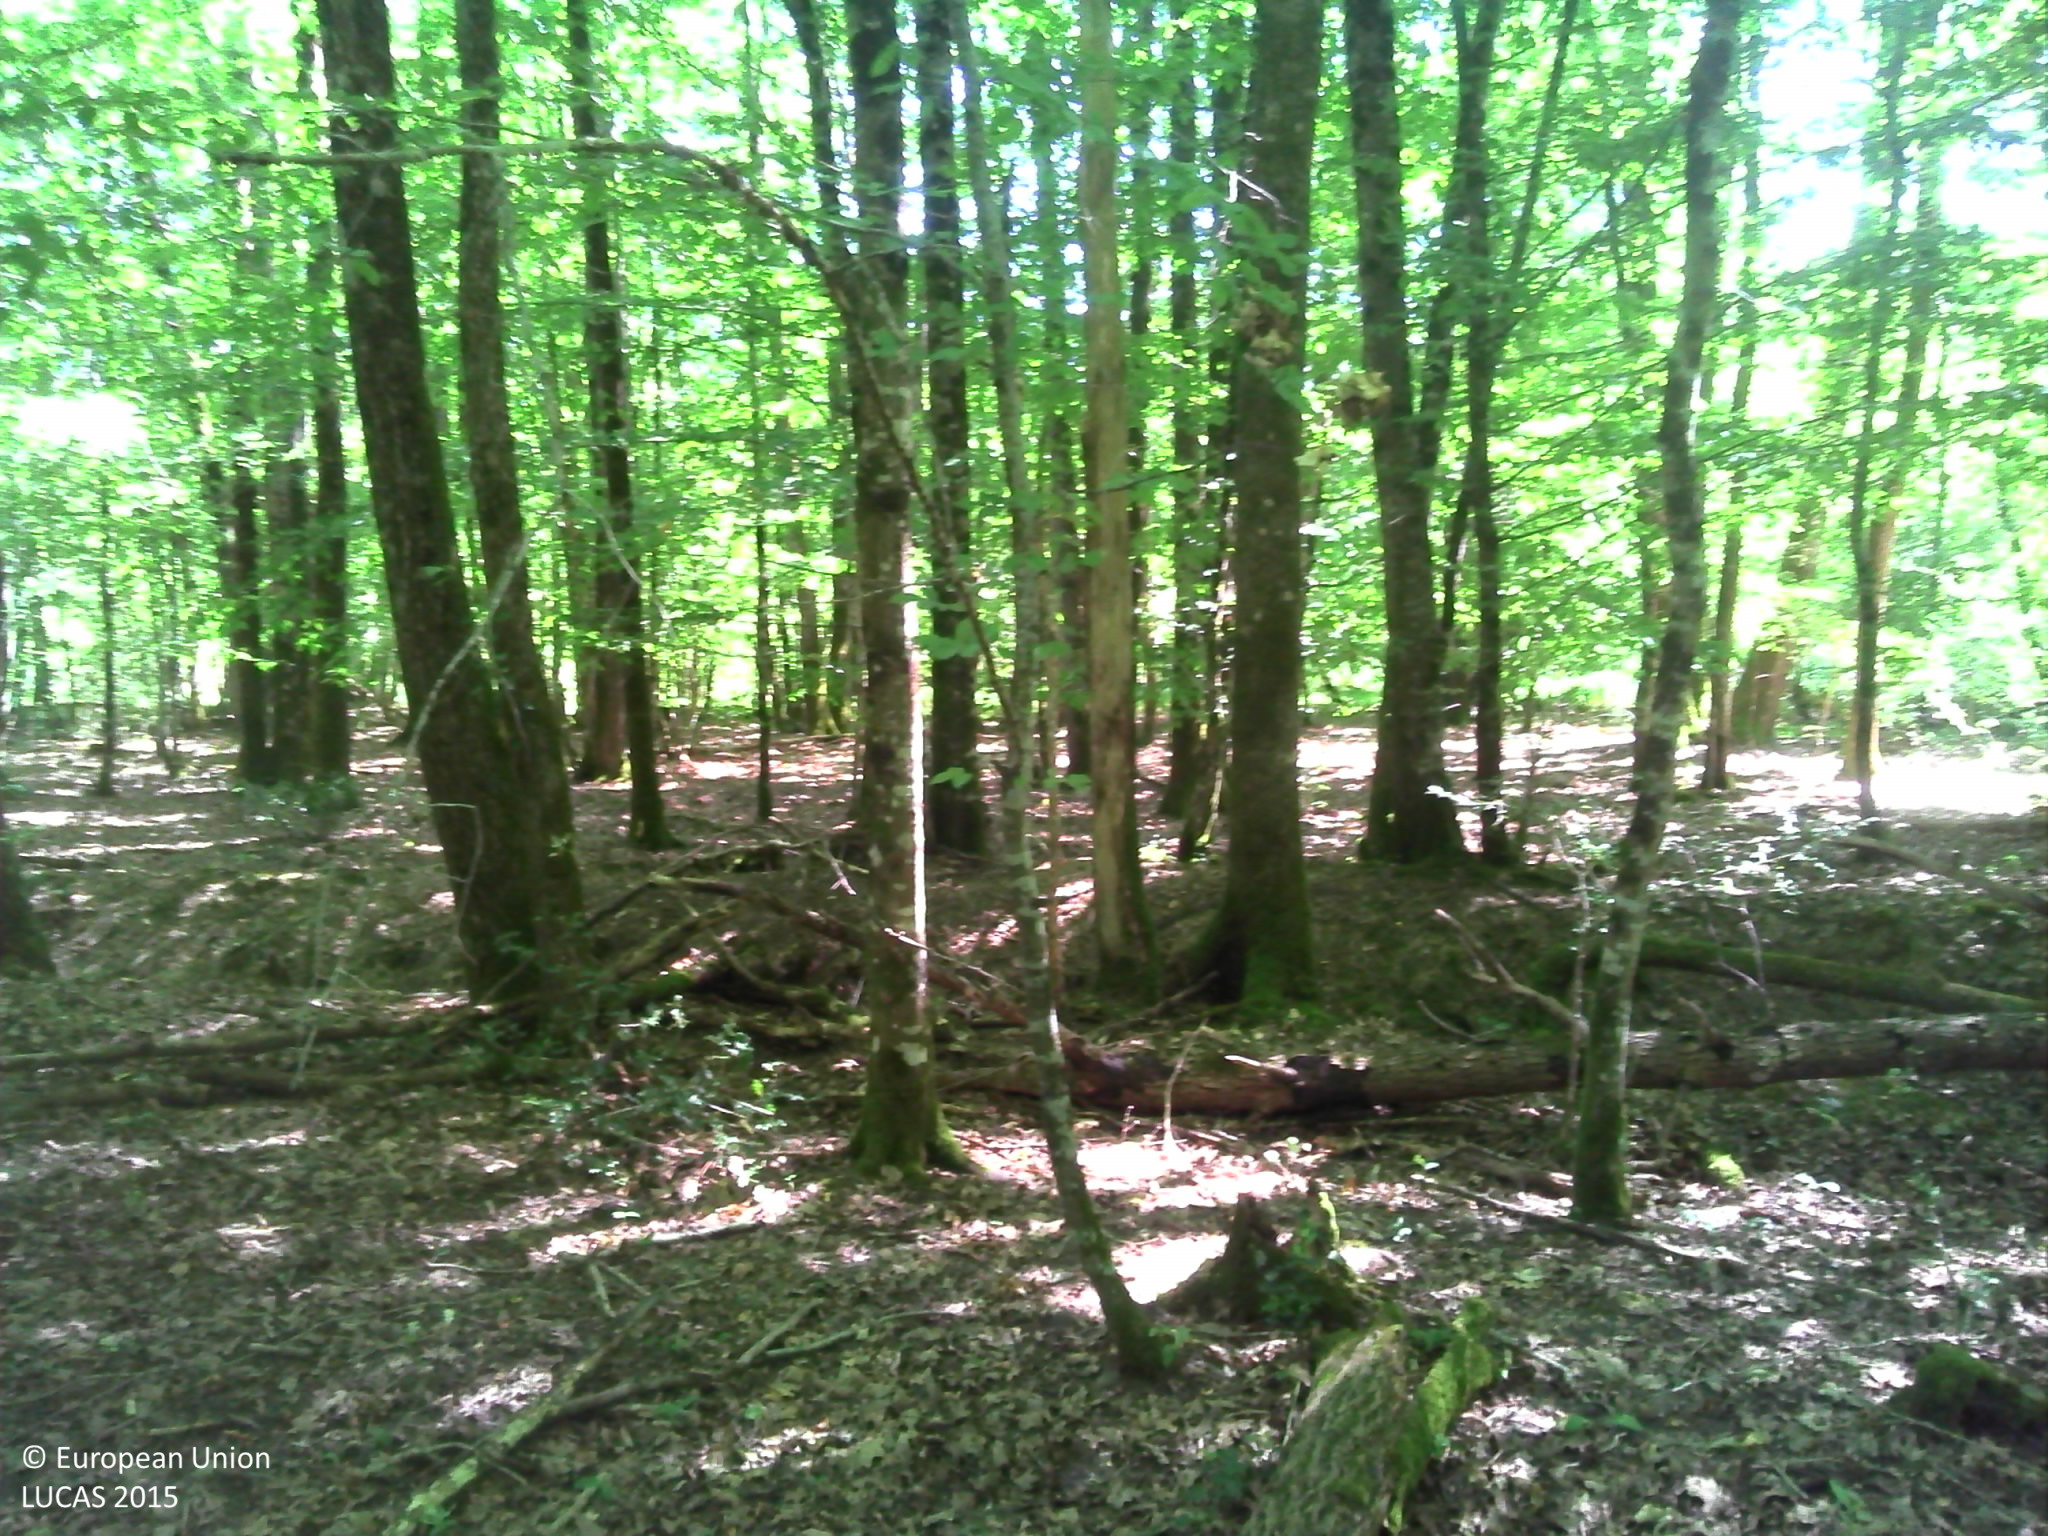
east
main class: Woodland
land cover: Broadleaved woodland
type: mesophytic deciduous forest
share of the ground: > 75 %
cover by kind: broadleaved forest trees 85 %, shrubs 5 %, herbaceous plants 5 %, lichens and mosses 5 %
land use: Forestry
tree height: > 5 m
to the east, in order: Broadleaved woodland; Ditches and canals; Broadleaved woodland; Pine dominated mixed woodland; Tracks; Pine dominated mixed woodland; Tracks; Broadleaved woodland; Ditches and canals; Broadleaved woodland
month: July
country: FR
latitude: 47.2714
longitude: 0.5287
